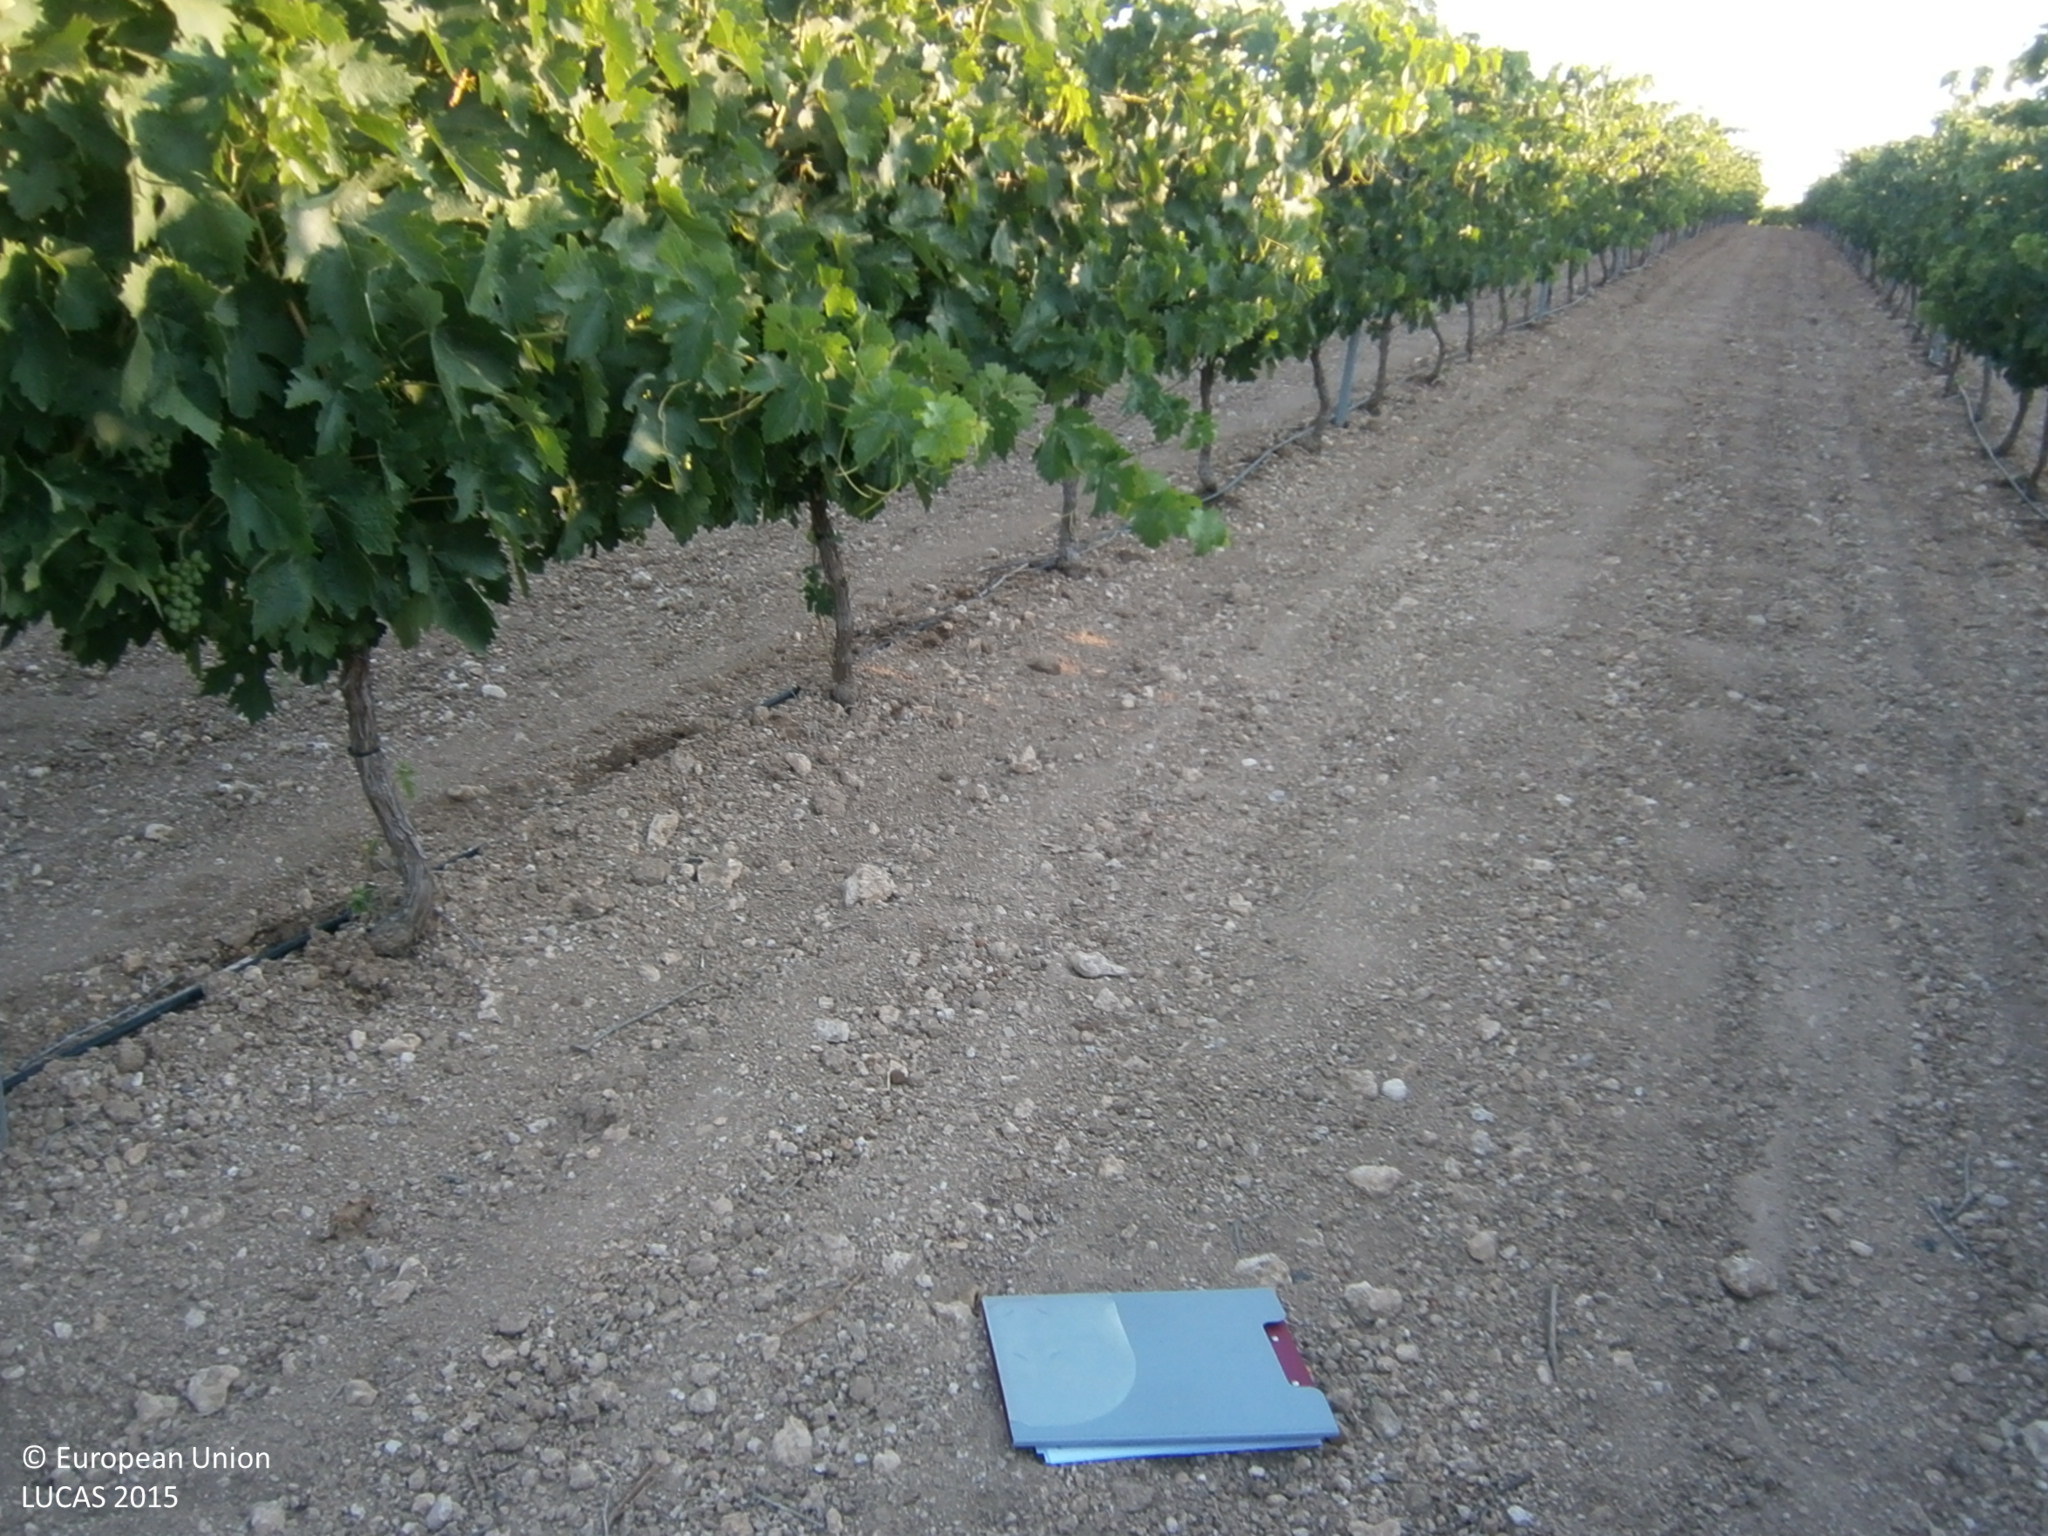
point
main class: Cropland
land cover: Vineyards
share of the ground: 25 - 50 %
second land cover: Other bare soil
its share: > 75 %
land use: Agriculture (excluding fallow land and kitchen gardens)
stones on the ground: 10 - 25 %
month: June
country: ES
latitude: 38.7290
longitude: -6.8237
